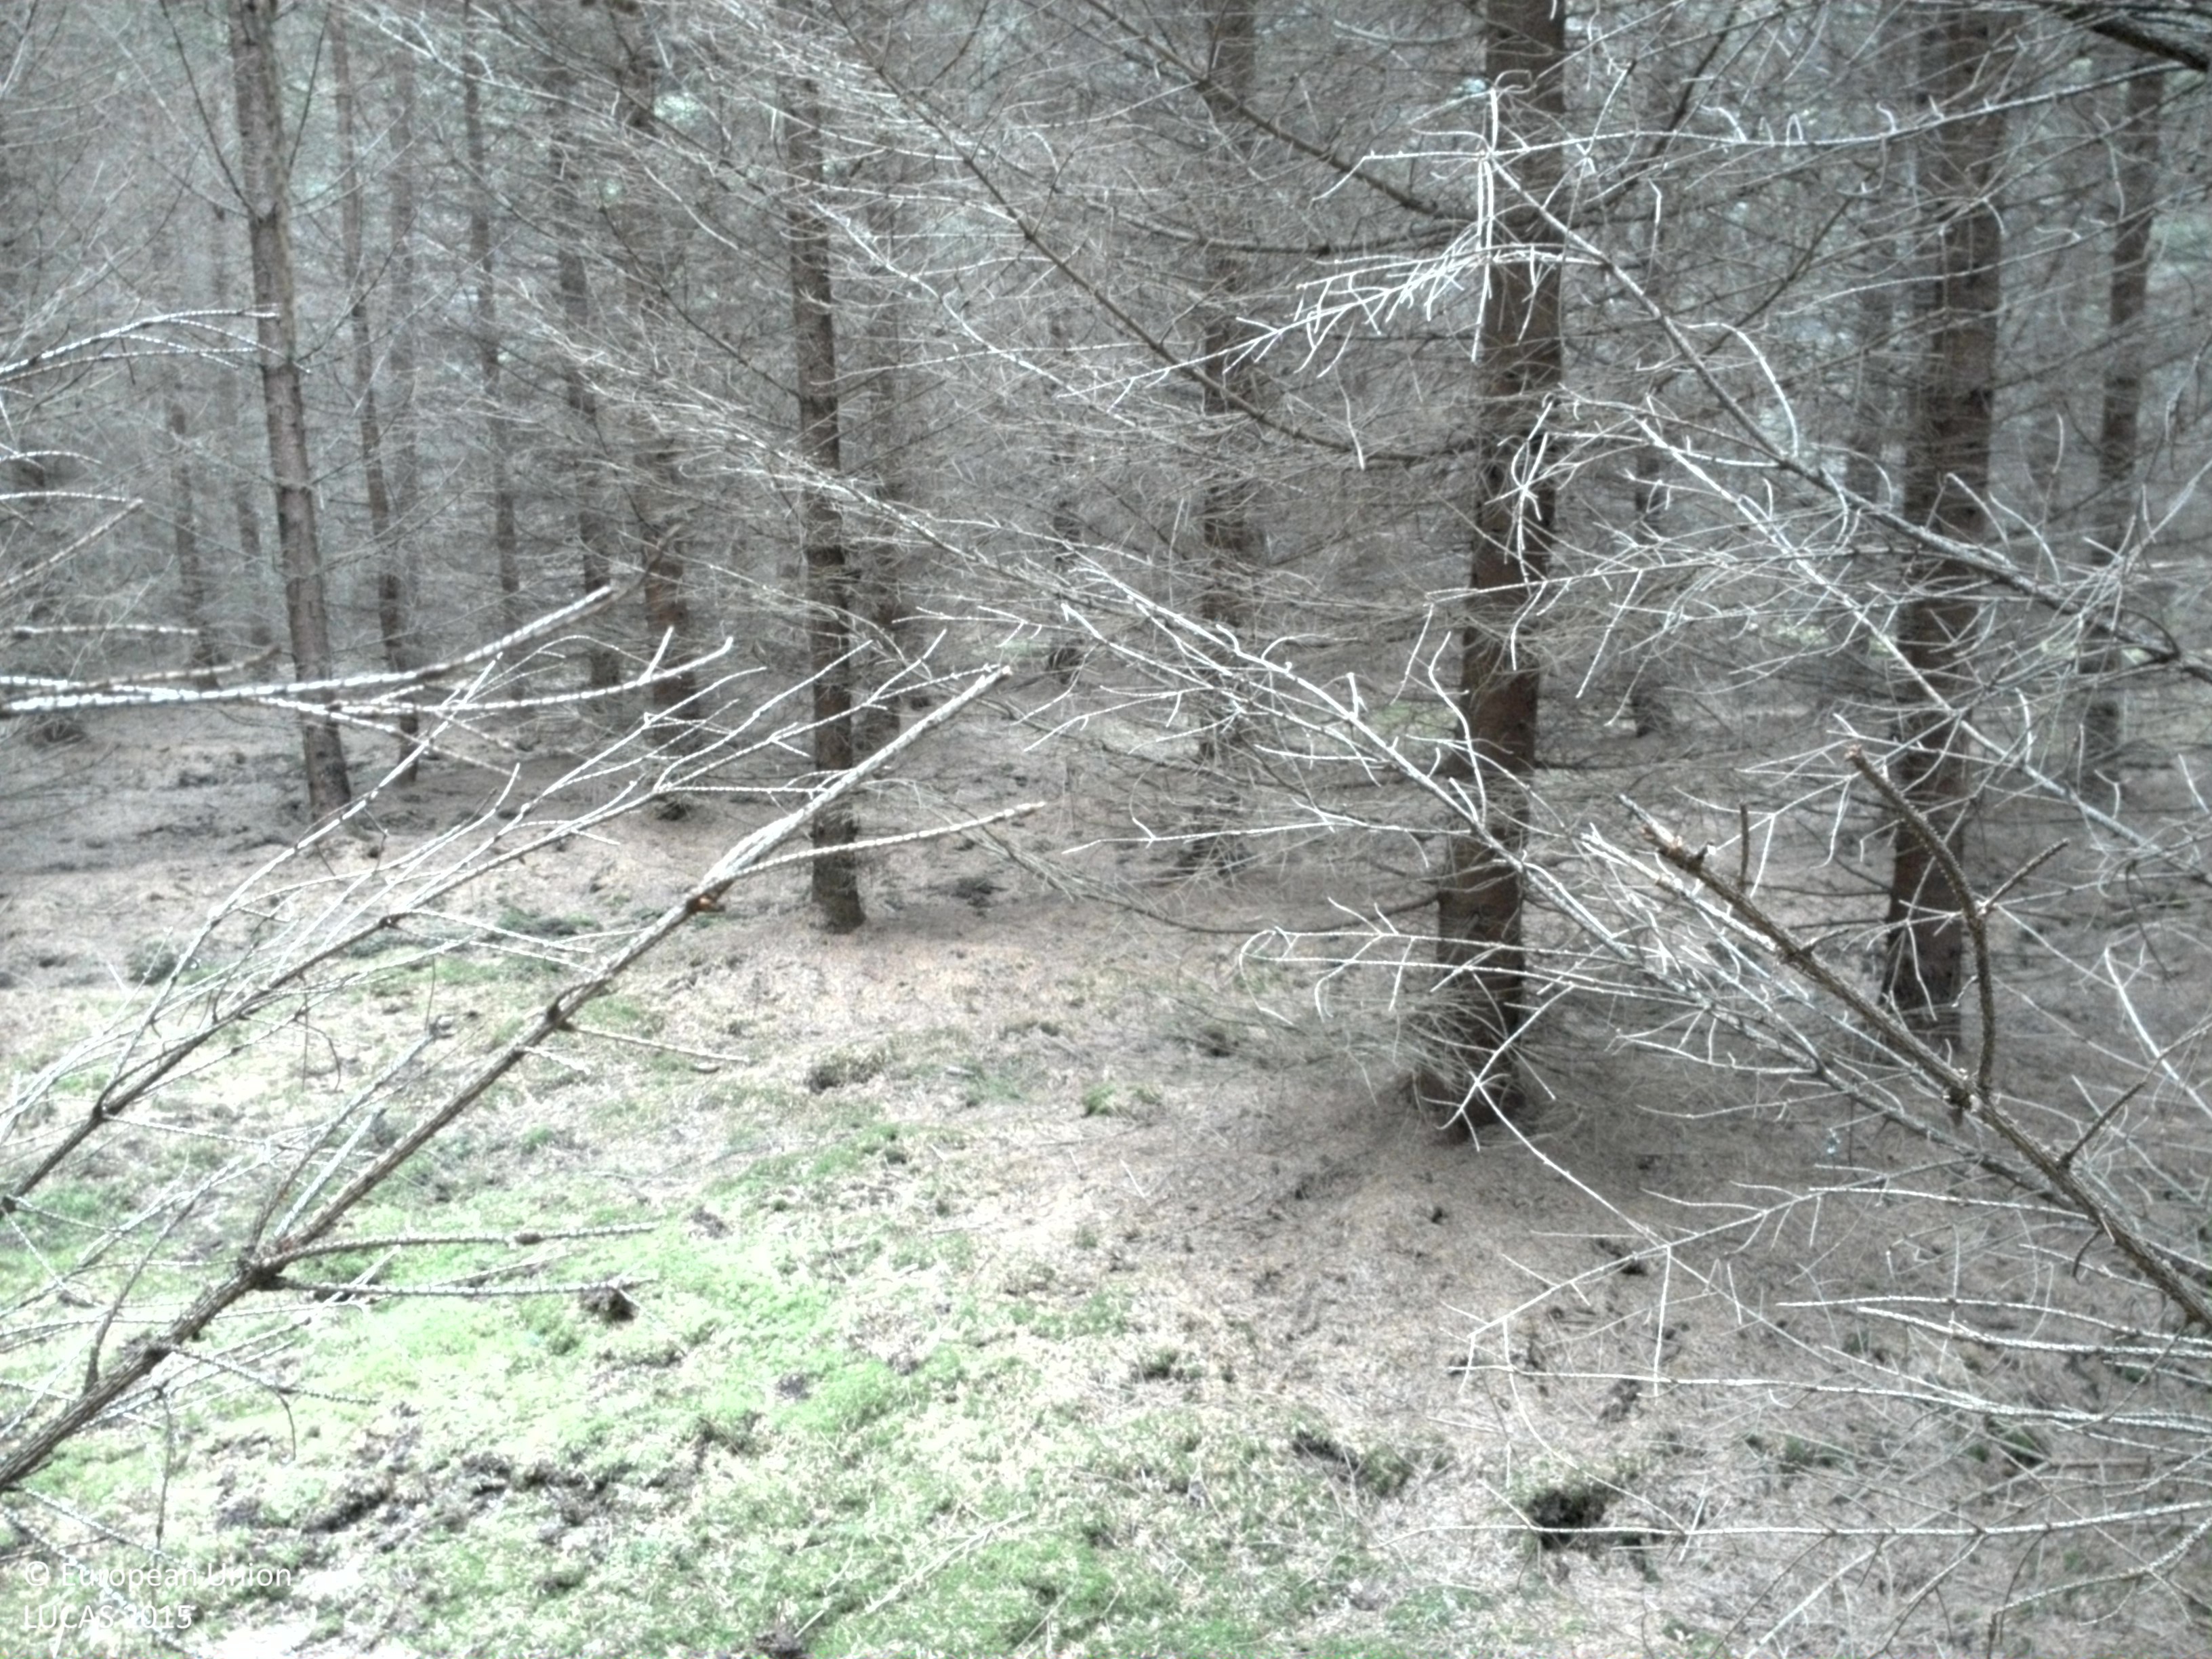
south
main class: Woodland
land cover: Spruce dominated coniferous woodland
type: boreal forest
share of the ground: > 75 %
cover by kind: coniferous forest trees 100 %
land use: Forestry
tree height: > 5 m
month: May
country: SE
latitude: 59.2545
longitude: 14.1481
